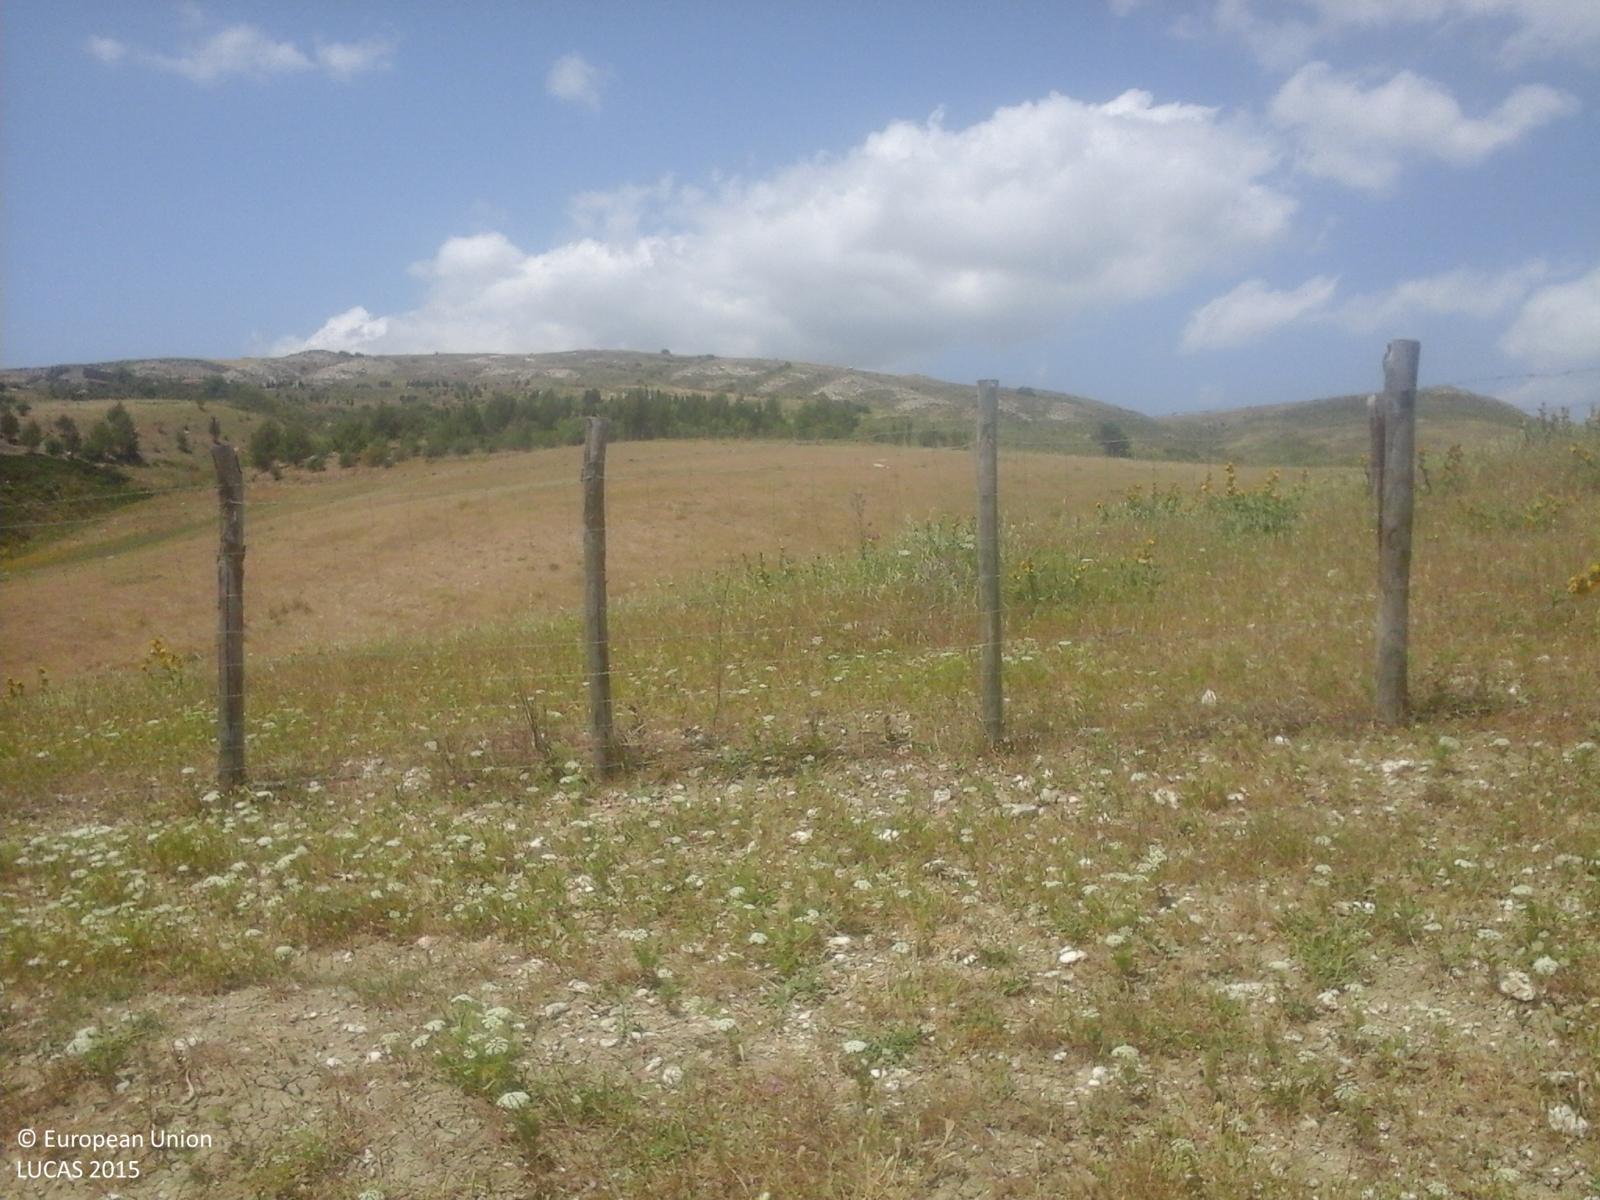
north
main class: Grassland
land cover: Grassland without tree/shrub cover
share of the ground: > 75 %
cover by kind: herbaceous plants 100 %
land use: Agriculture (excluding fallow land and kitchen gardens)
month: May
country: IT
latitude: 37.6549
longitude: 14.1974
